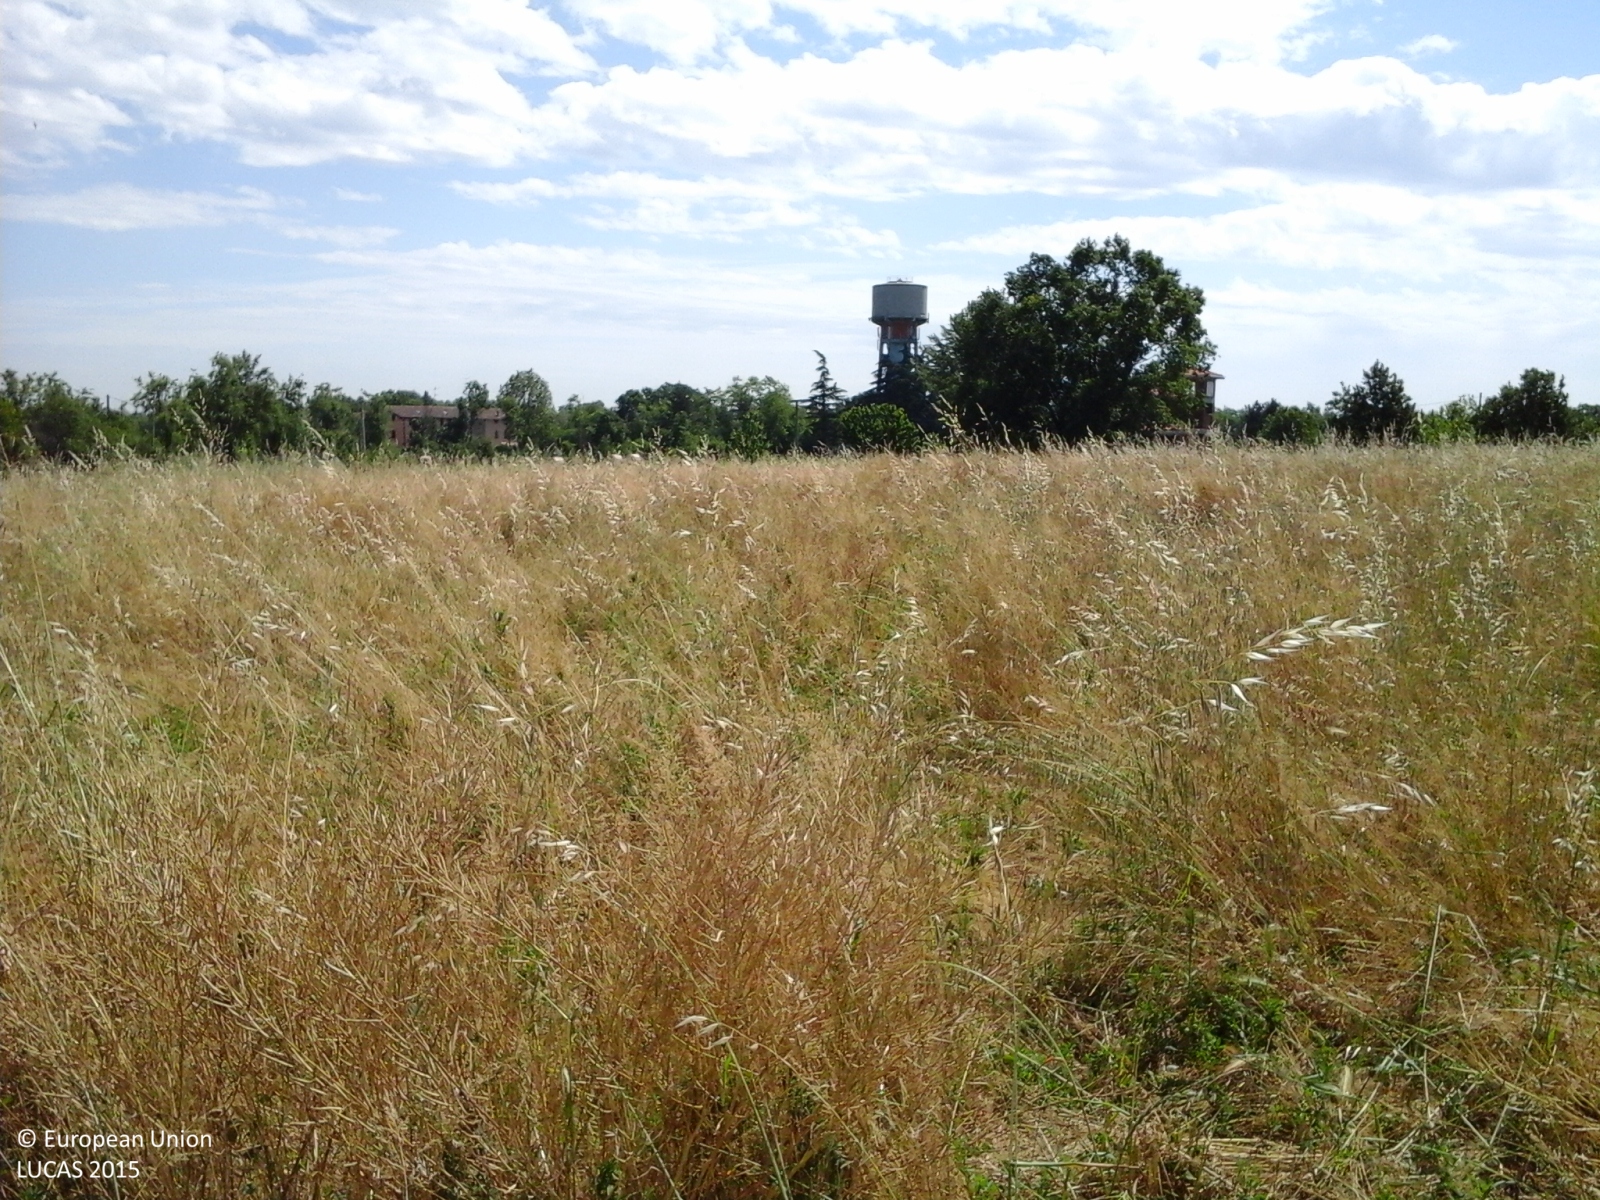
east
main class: Grassland
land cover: Spontaneously vegetated surfaces
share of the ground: > 75 %
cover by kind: herbaceous plants 100 %
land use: Agriculture (excluding fallow land and kitchen gardens)
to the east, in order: Spontaneously vegetated surfaces; Tracks; Grassland without tree/shrub cover; Lines of trees; Electric lines; Grass margins; Ditches and canals; Paved roads, cycling and walking lanes; Ditches and canals; Fences; Electric lines; Grassland without tree/shrub cover; Artificial constructions in urban areas; Managed hedges; Grassland without tree/shrub cover; Fences; Grassland without tree/shrub cover
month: May
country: IT
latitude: 44.6555
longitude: 10.5914
